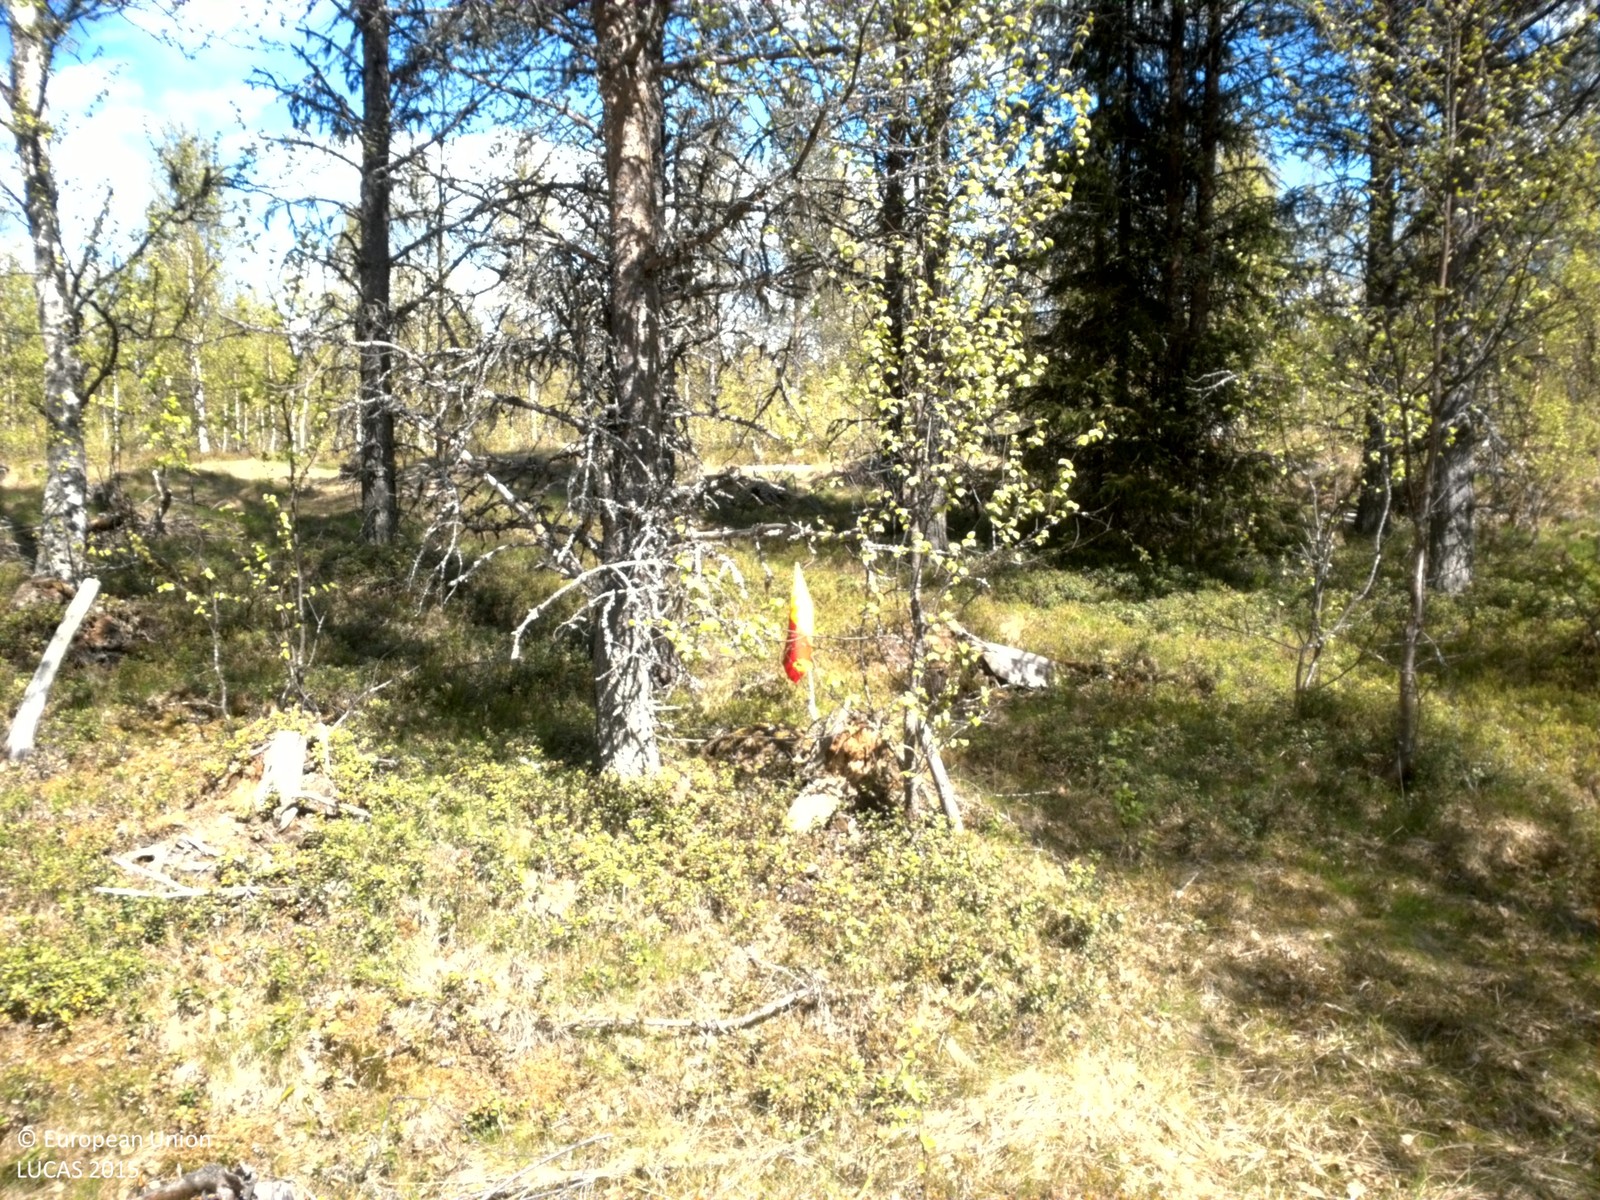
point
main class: Woodland
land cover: Pine dominated mixed woodland
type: boreal forest
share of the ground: 25 - 50 %
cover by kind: coniferous forest trees 30 %, herbaceous plants 30 %, broadleaved forest trees 20 %, shrubs 10 %, lichens and mosses 10 %
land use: Forestry
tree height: > 5 m
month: June
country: SE
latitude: 64.3543
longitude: 17.3611
